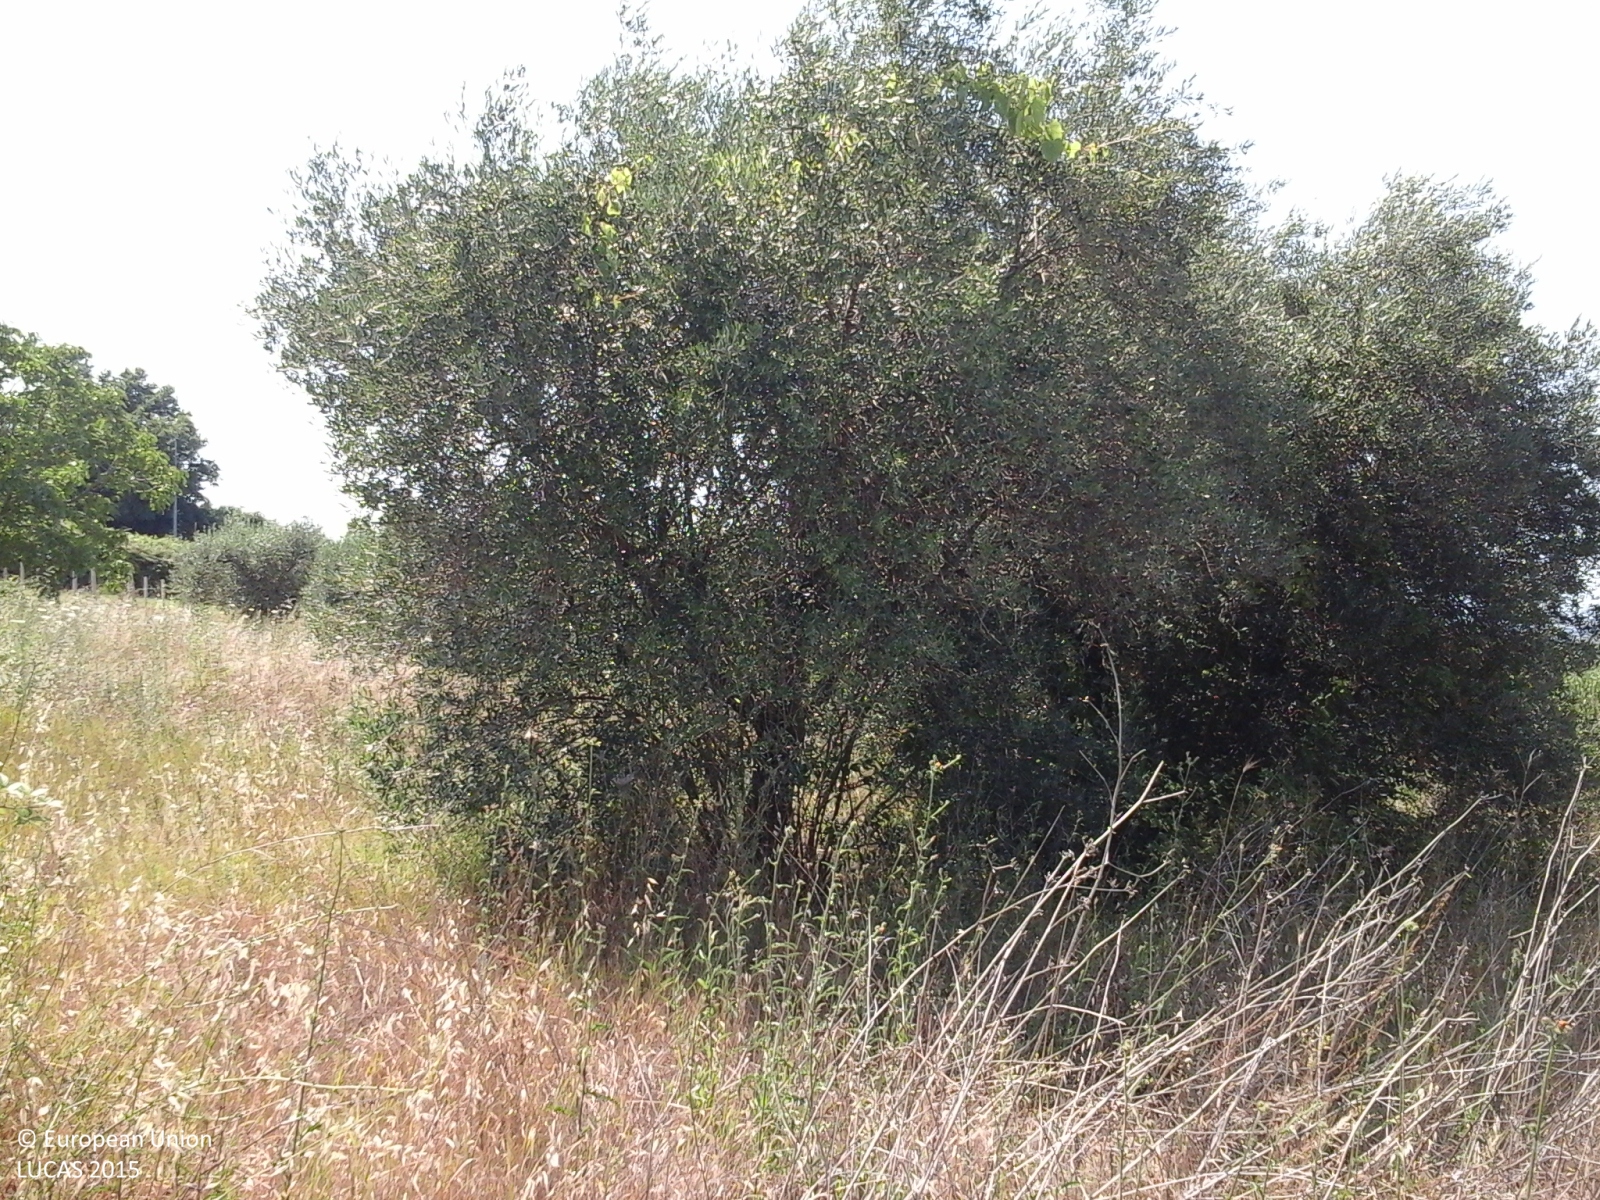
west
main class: Cropland
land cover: Olive groves
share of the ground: 25 - 50 %
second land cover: Grassland without tree/shrub cover
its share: > 75 %
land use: Agriculture (excluding fallow land and kitchen gardens)
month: July
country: IT
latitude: 41.8395
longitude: 12.7475
